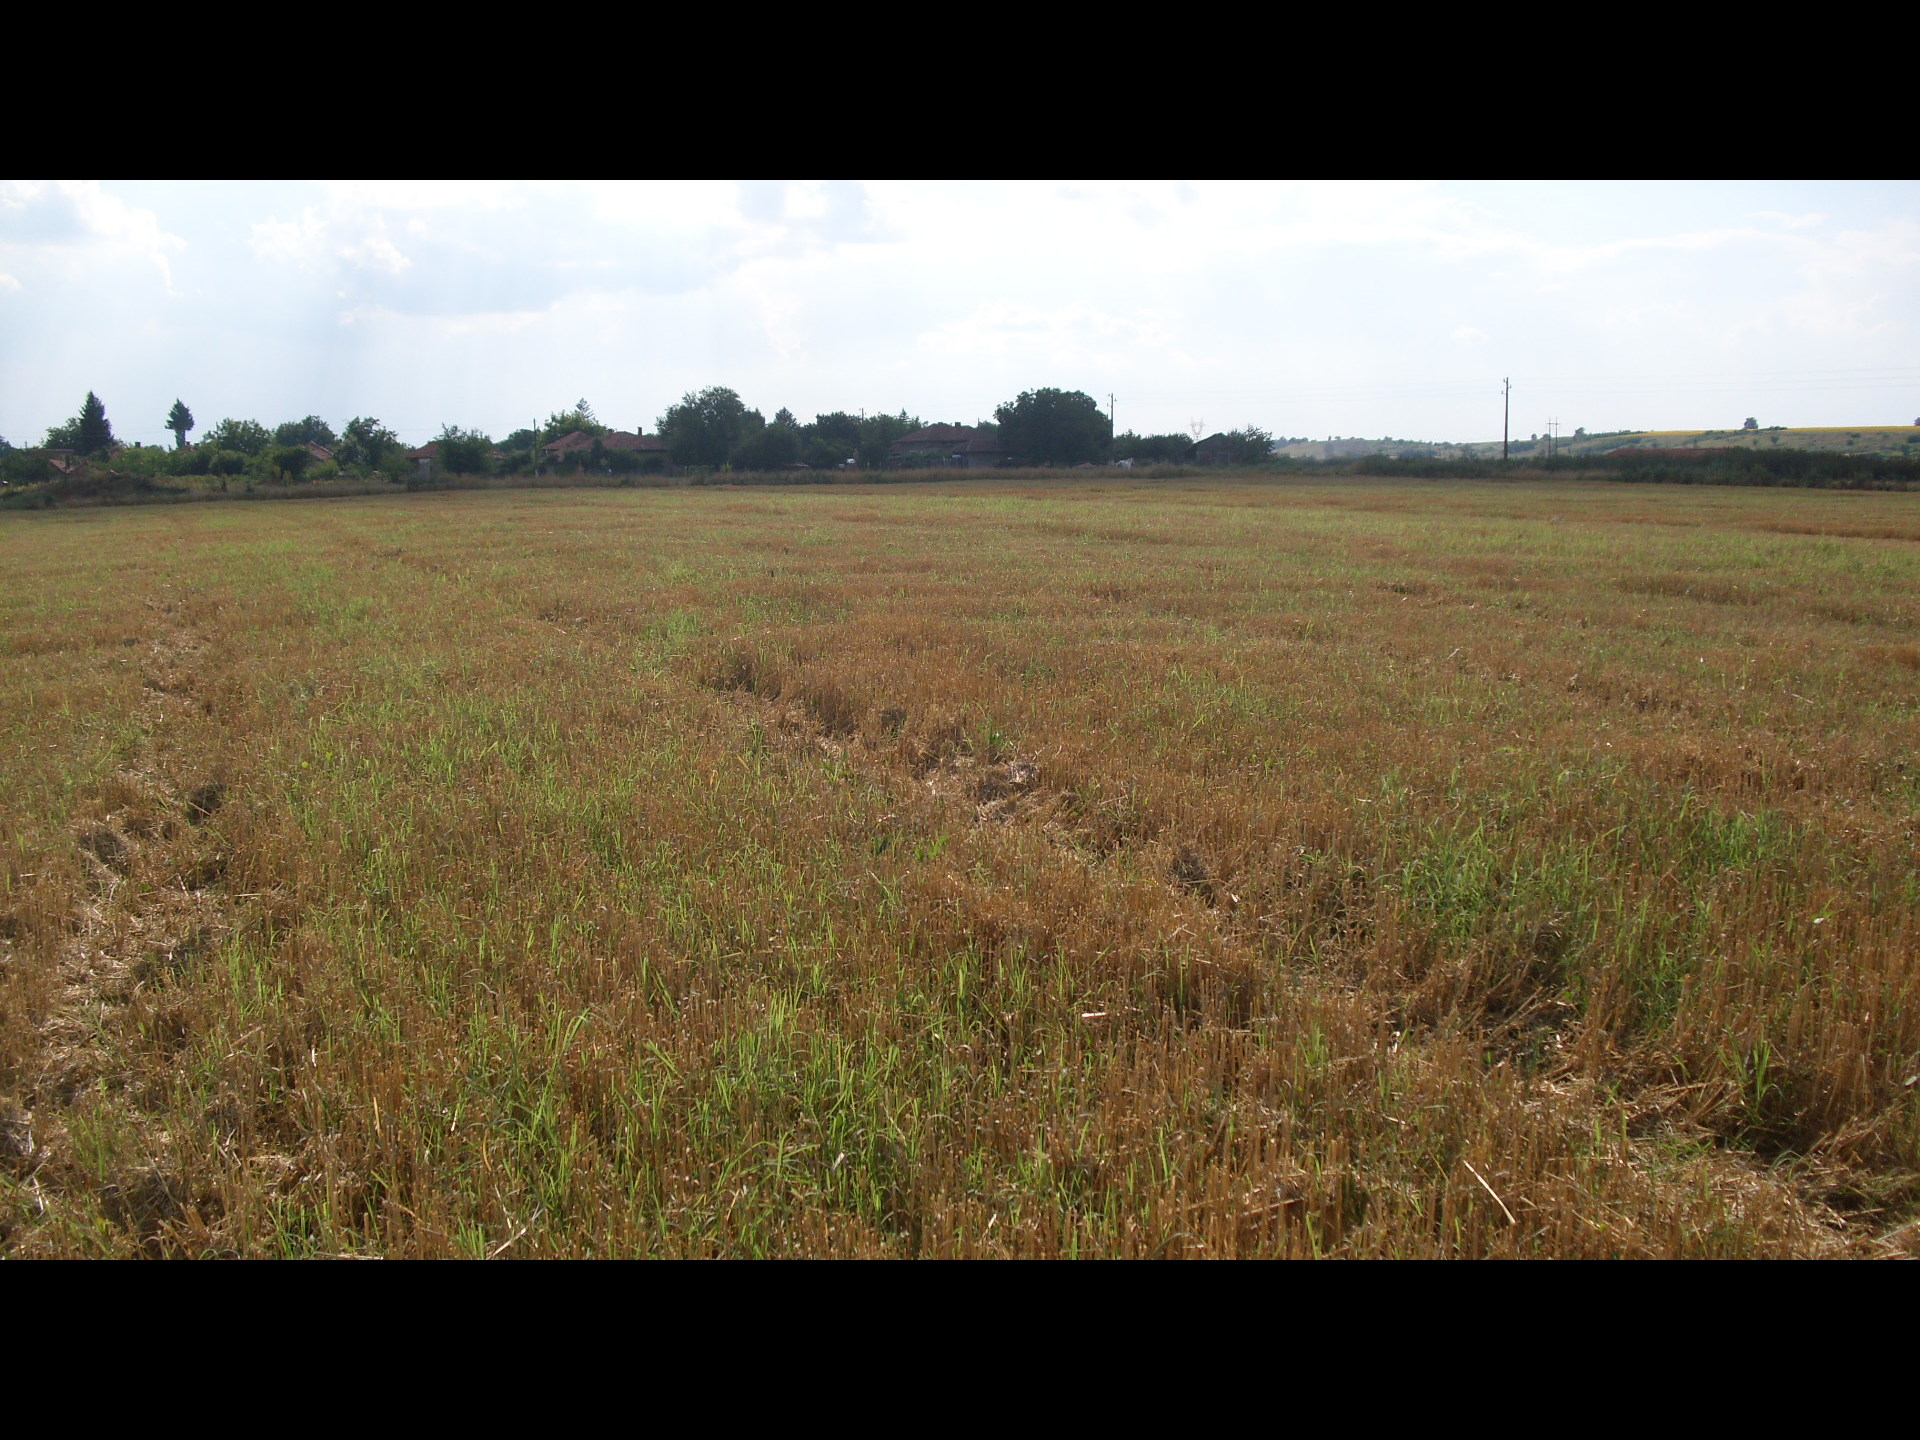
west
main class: Cropland
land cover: Common wheat
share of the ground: > 75 %
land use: Agriculture (excluding fallow land and kitchen gardens)
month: July
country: BG
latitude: 43.7155
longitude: 23.1102
